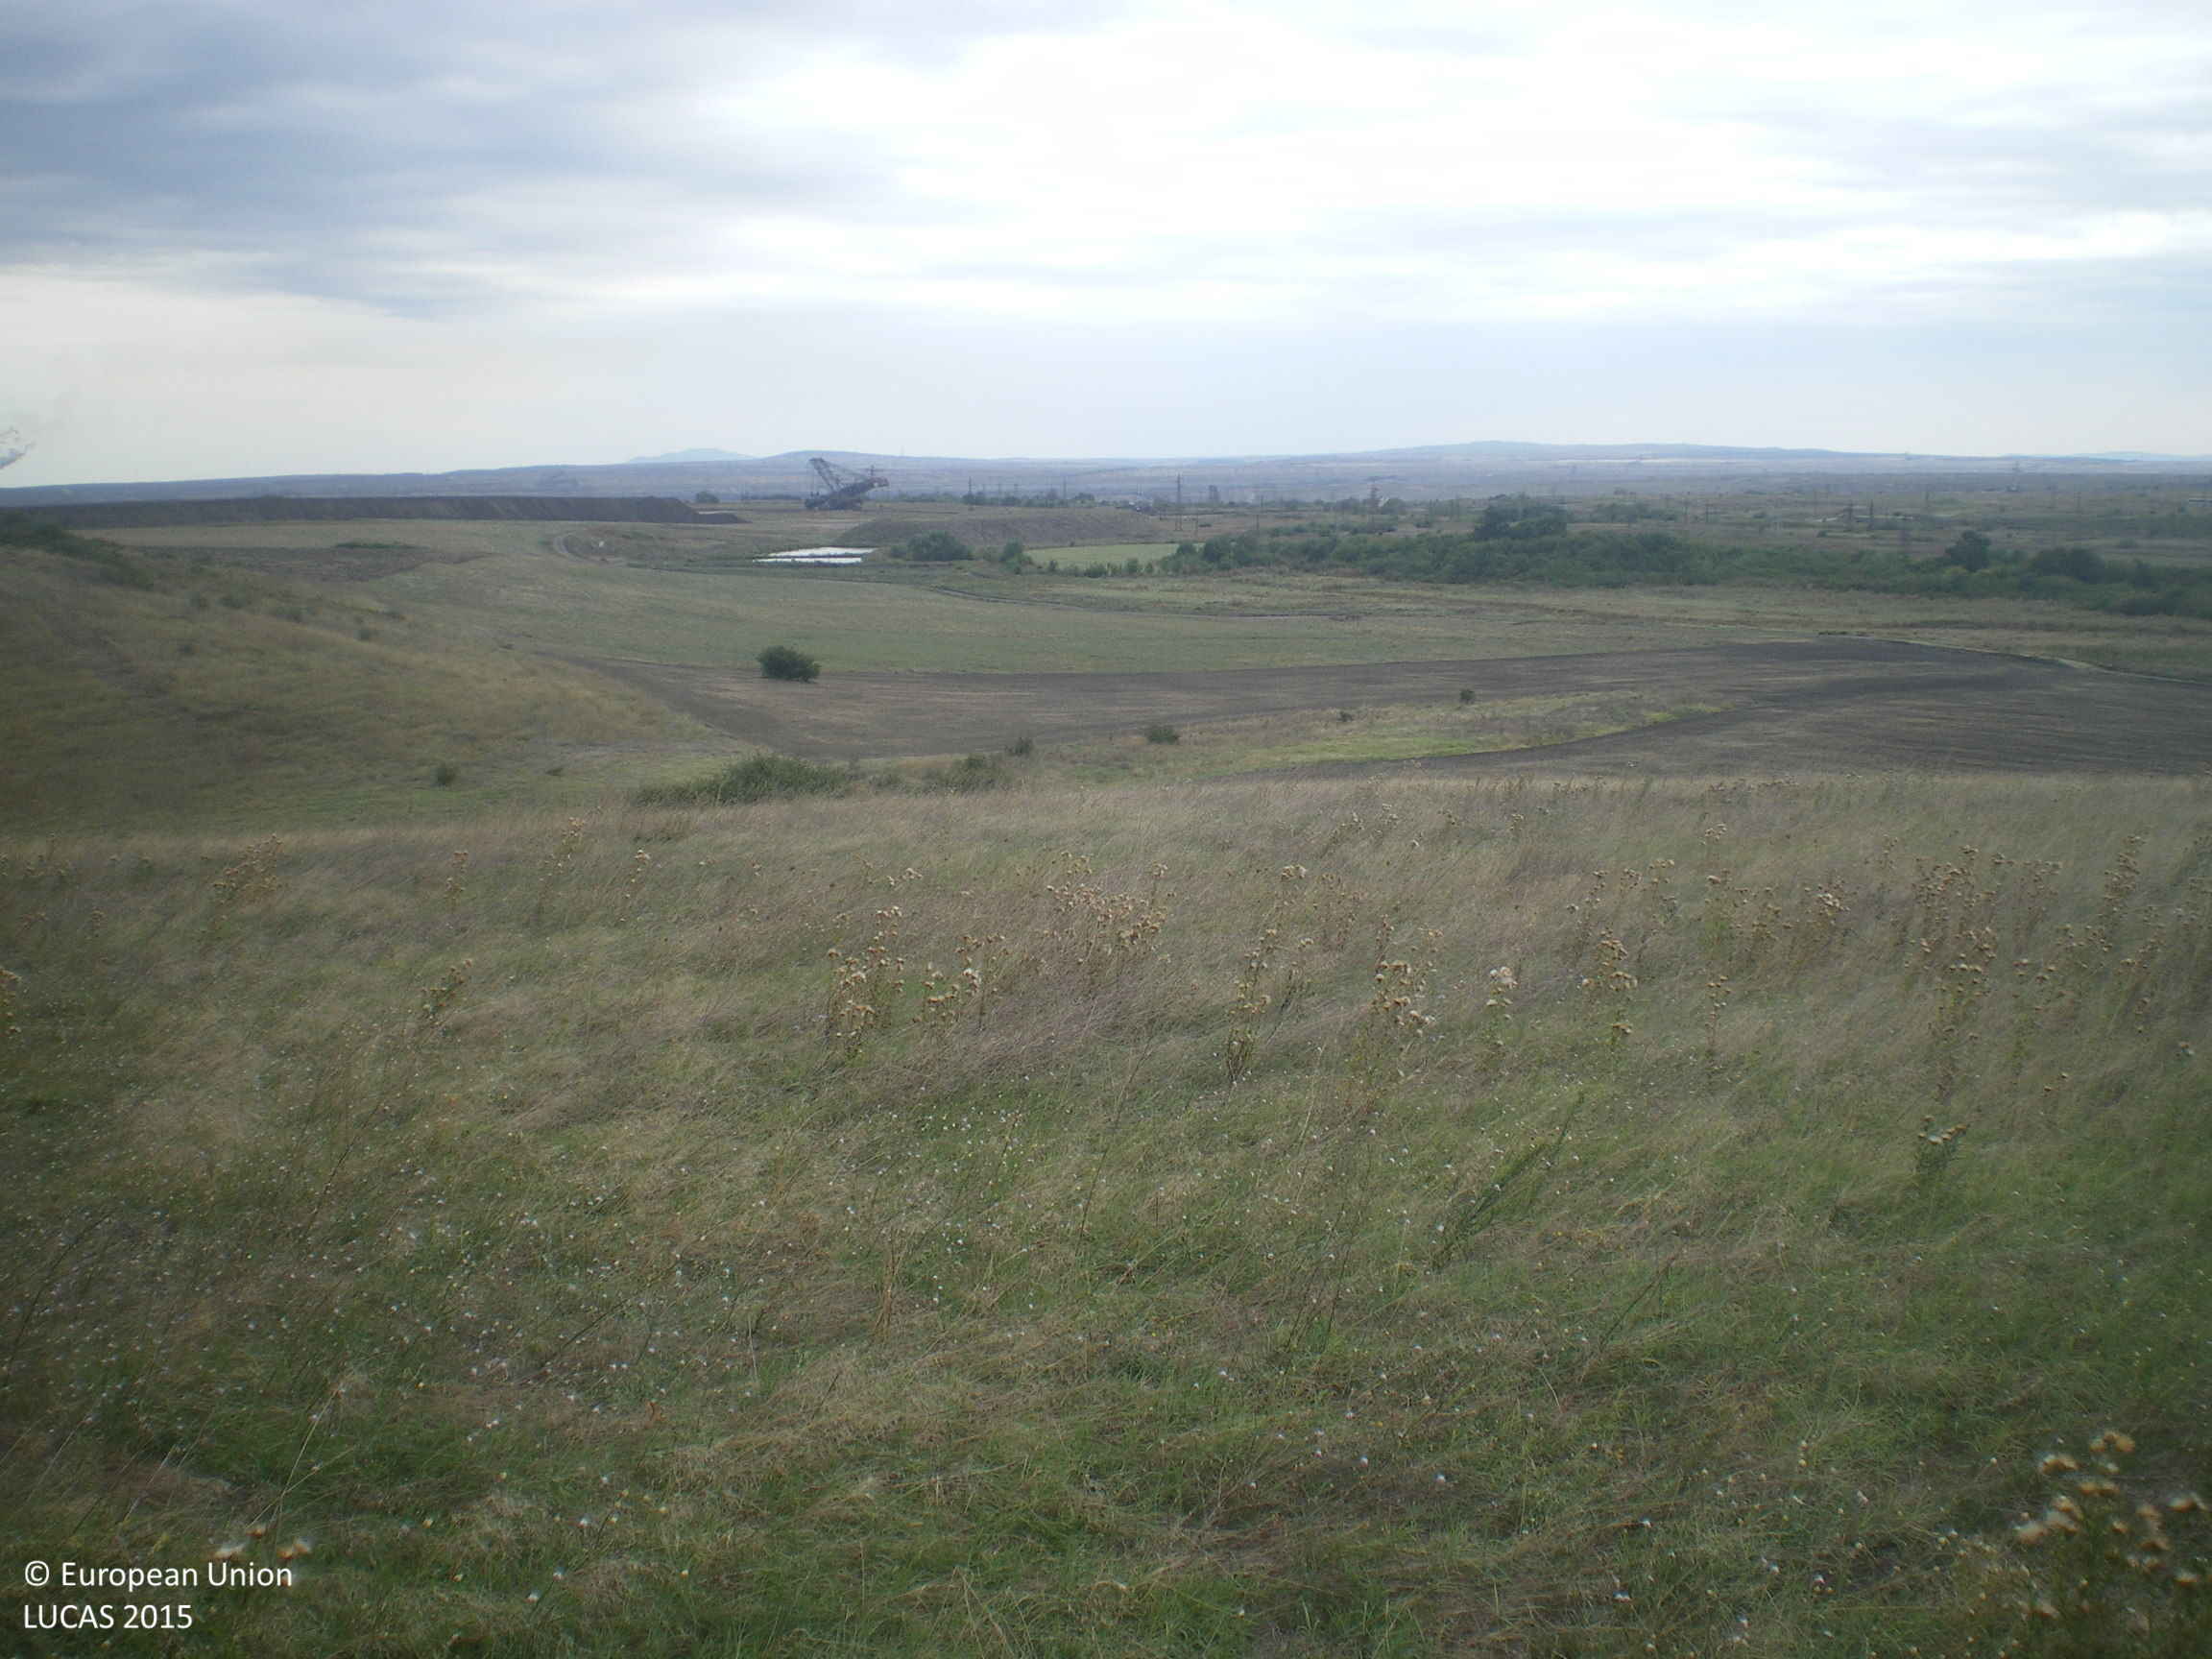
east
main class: Grassland
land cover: Grassland without tree/shrub cover
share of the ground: > 75 %
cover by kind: herbaceous plants 100 %
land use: Agriculture (excluding fallow land and kitchen gardens)
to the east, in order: Grassland without tree/shrub cover; Tracks; Shrubland without tree cover; Grassland without tree/shrub cover; Single bushes/trees; Grassland without tree/shrub cover; Common wheat
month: September
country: BG
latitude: 42.2066
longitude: 25.9550
